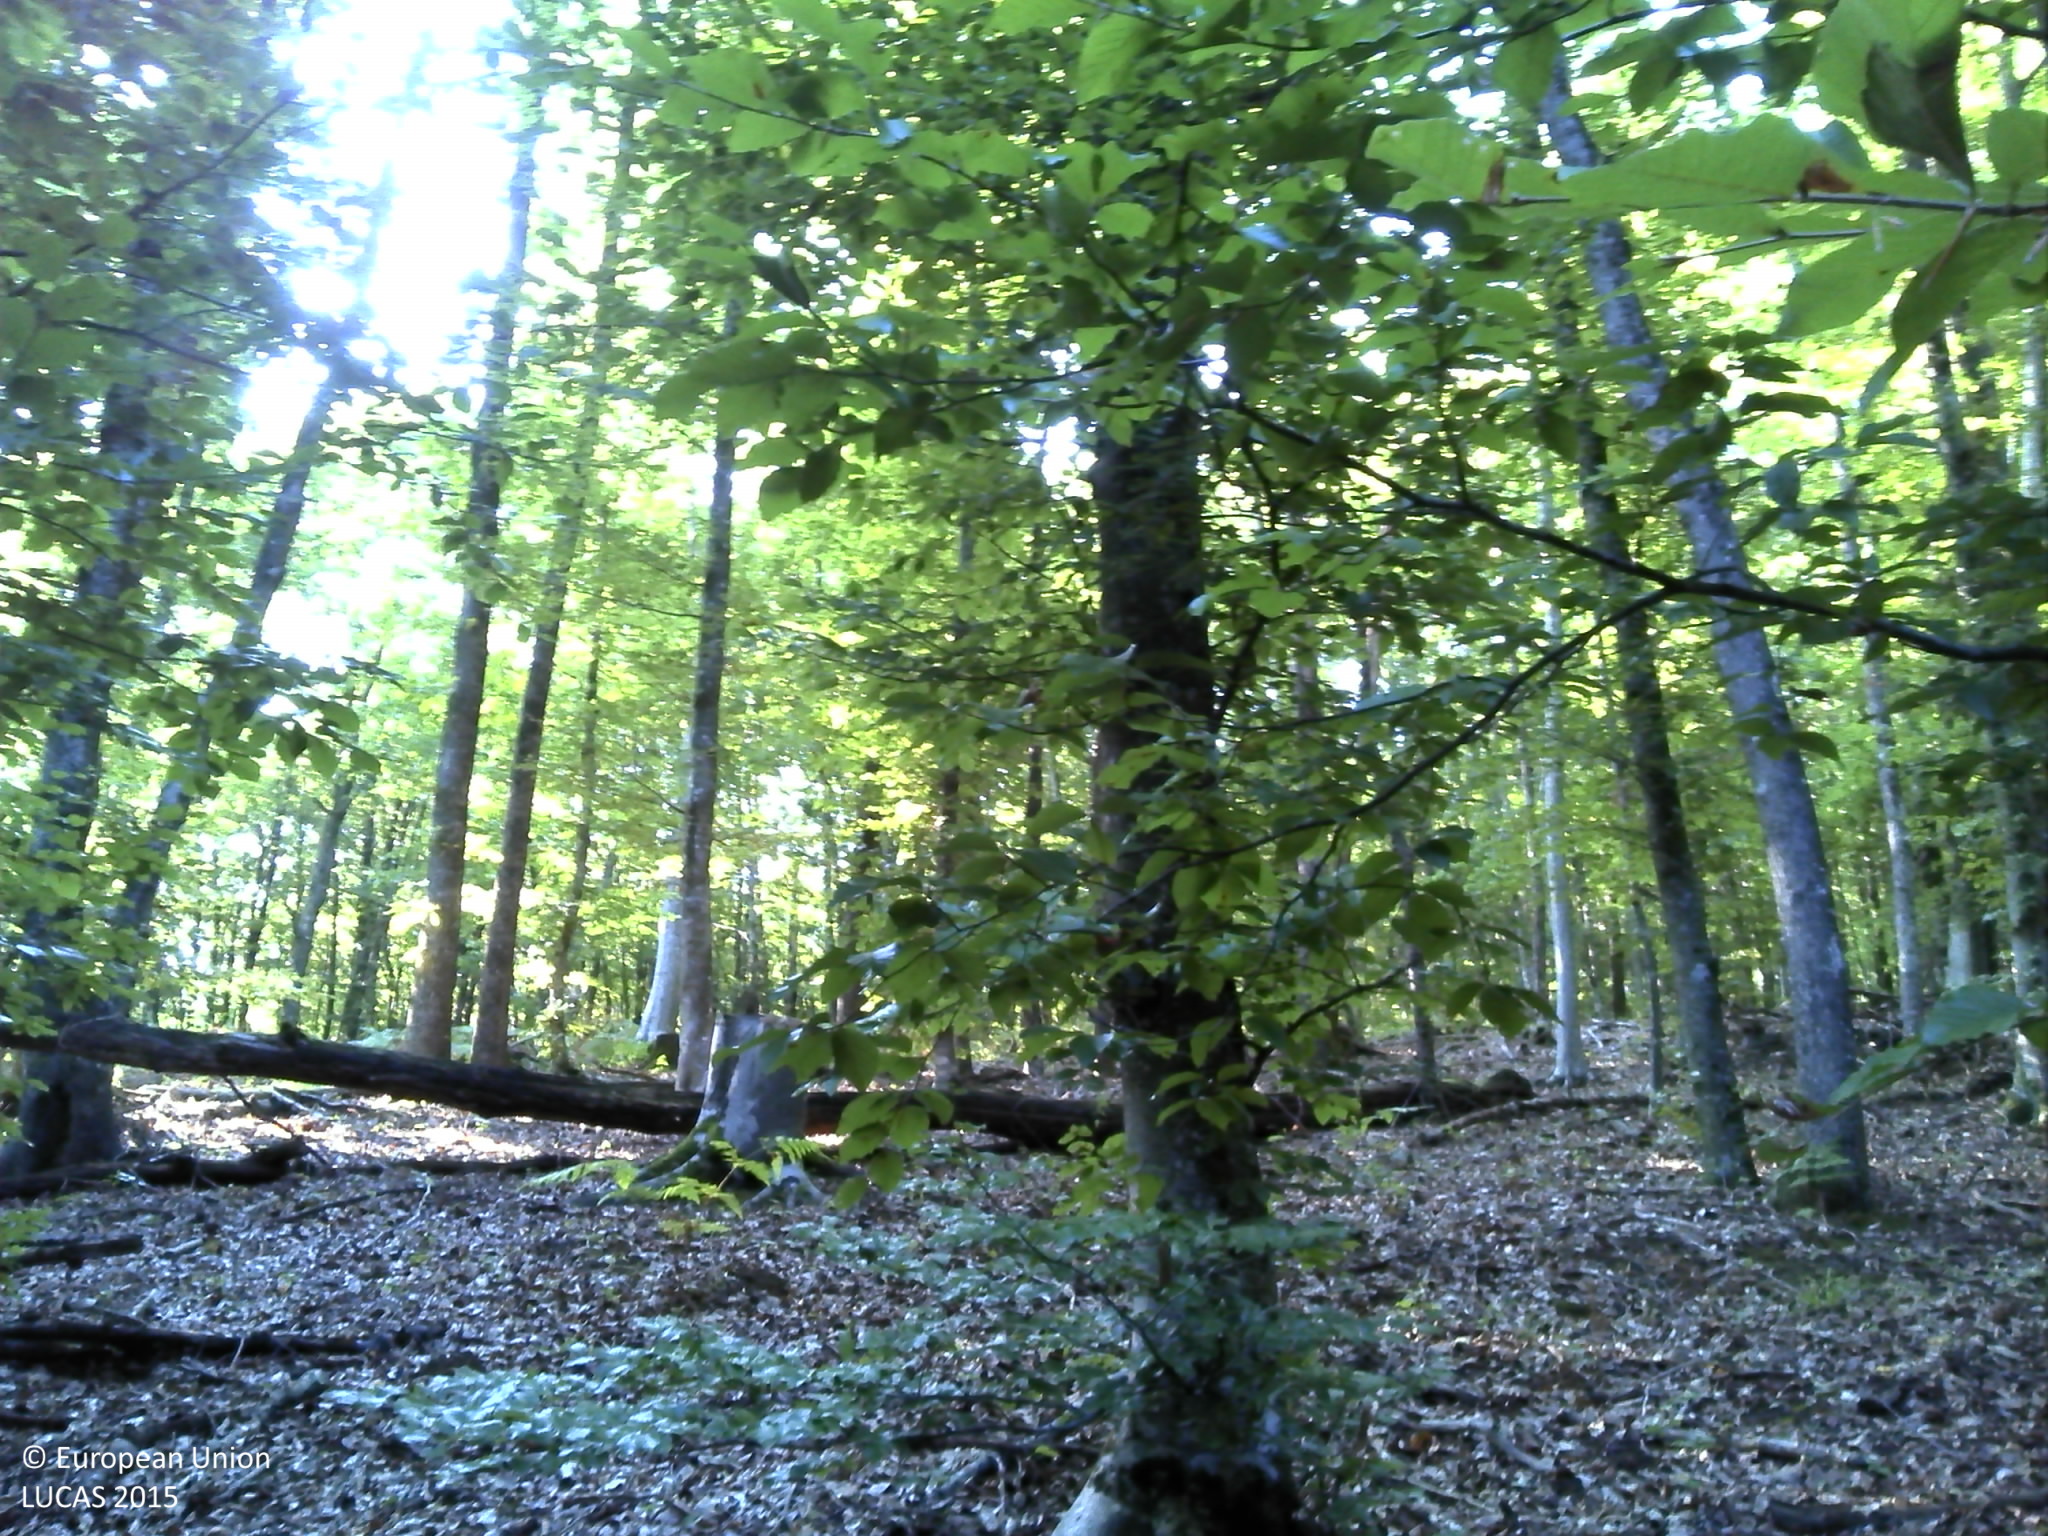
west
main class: Woodland
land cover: Broadleaved woodland
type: mesophytic deciduous forest
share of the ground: > 75 %
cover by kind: broadleaved forest trees 100 %
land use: Forestry
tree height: > 5 m
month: August
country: HR
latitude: 45.2384
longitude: 15.7665
